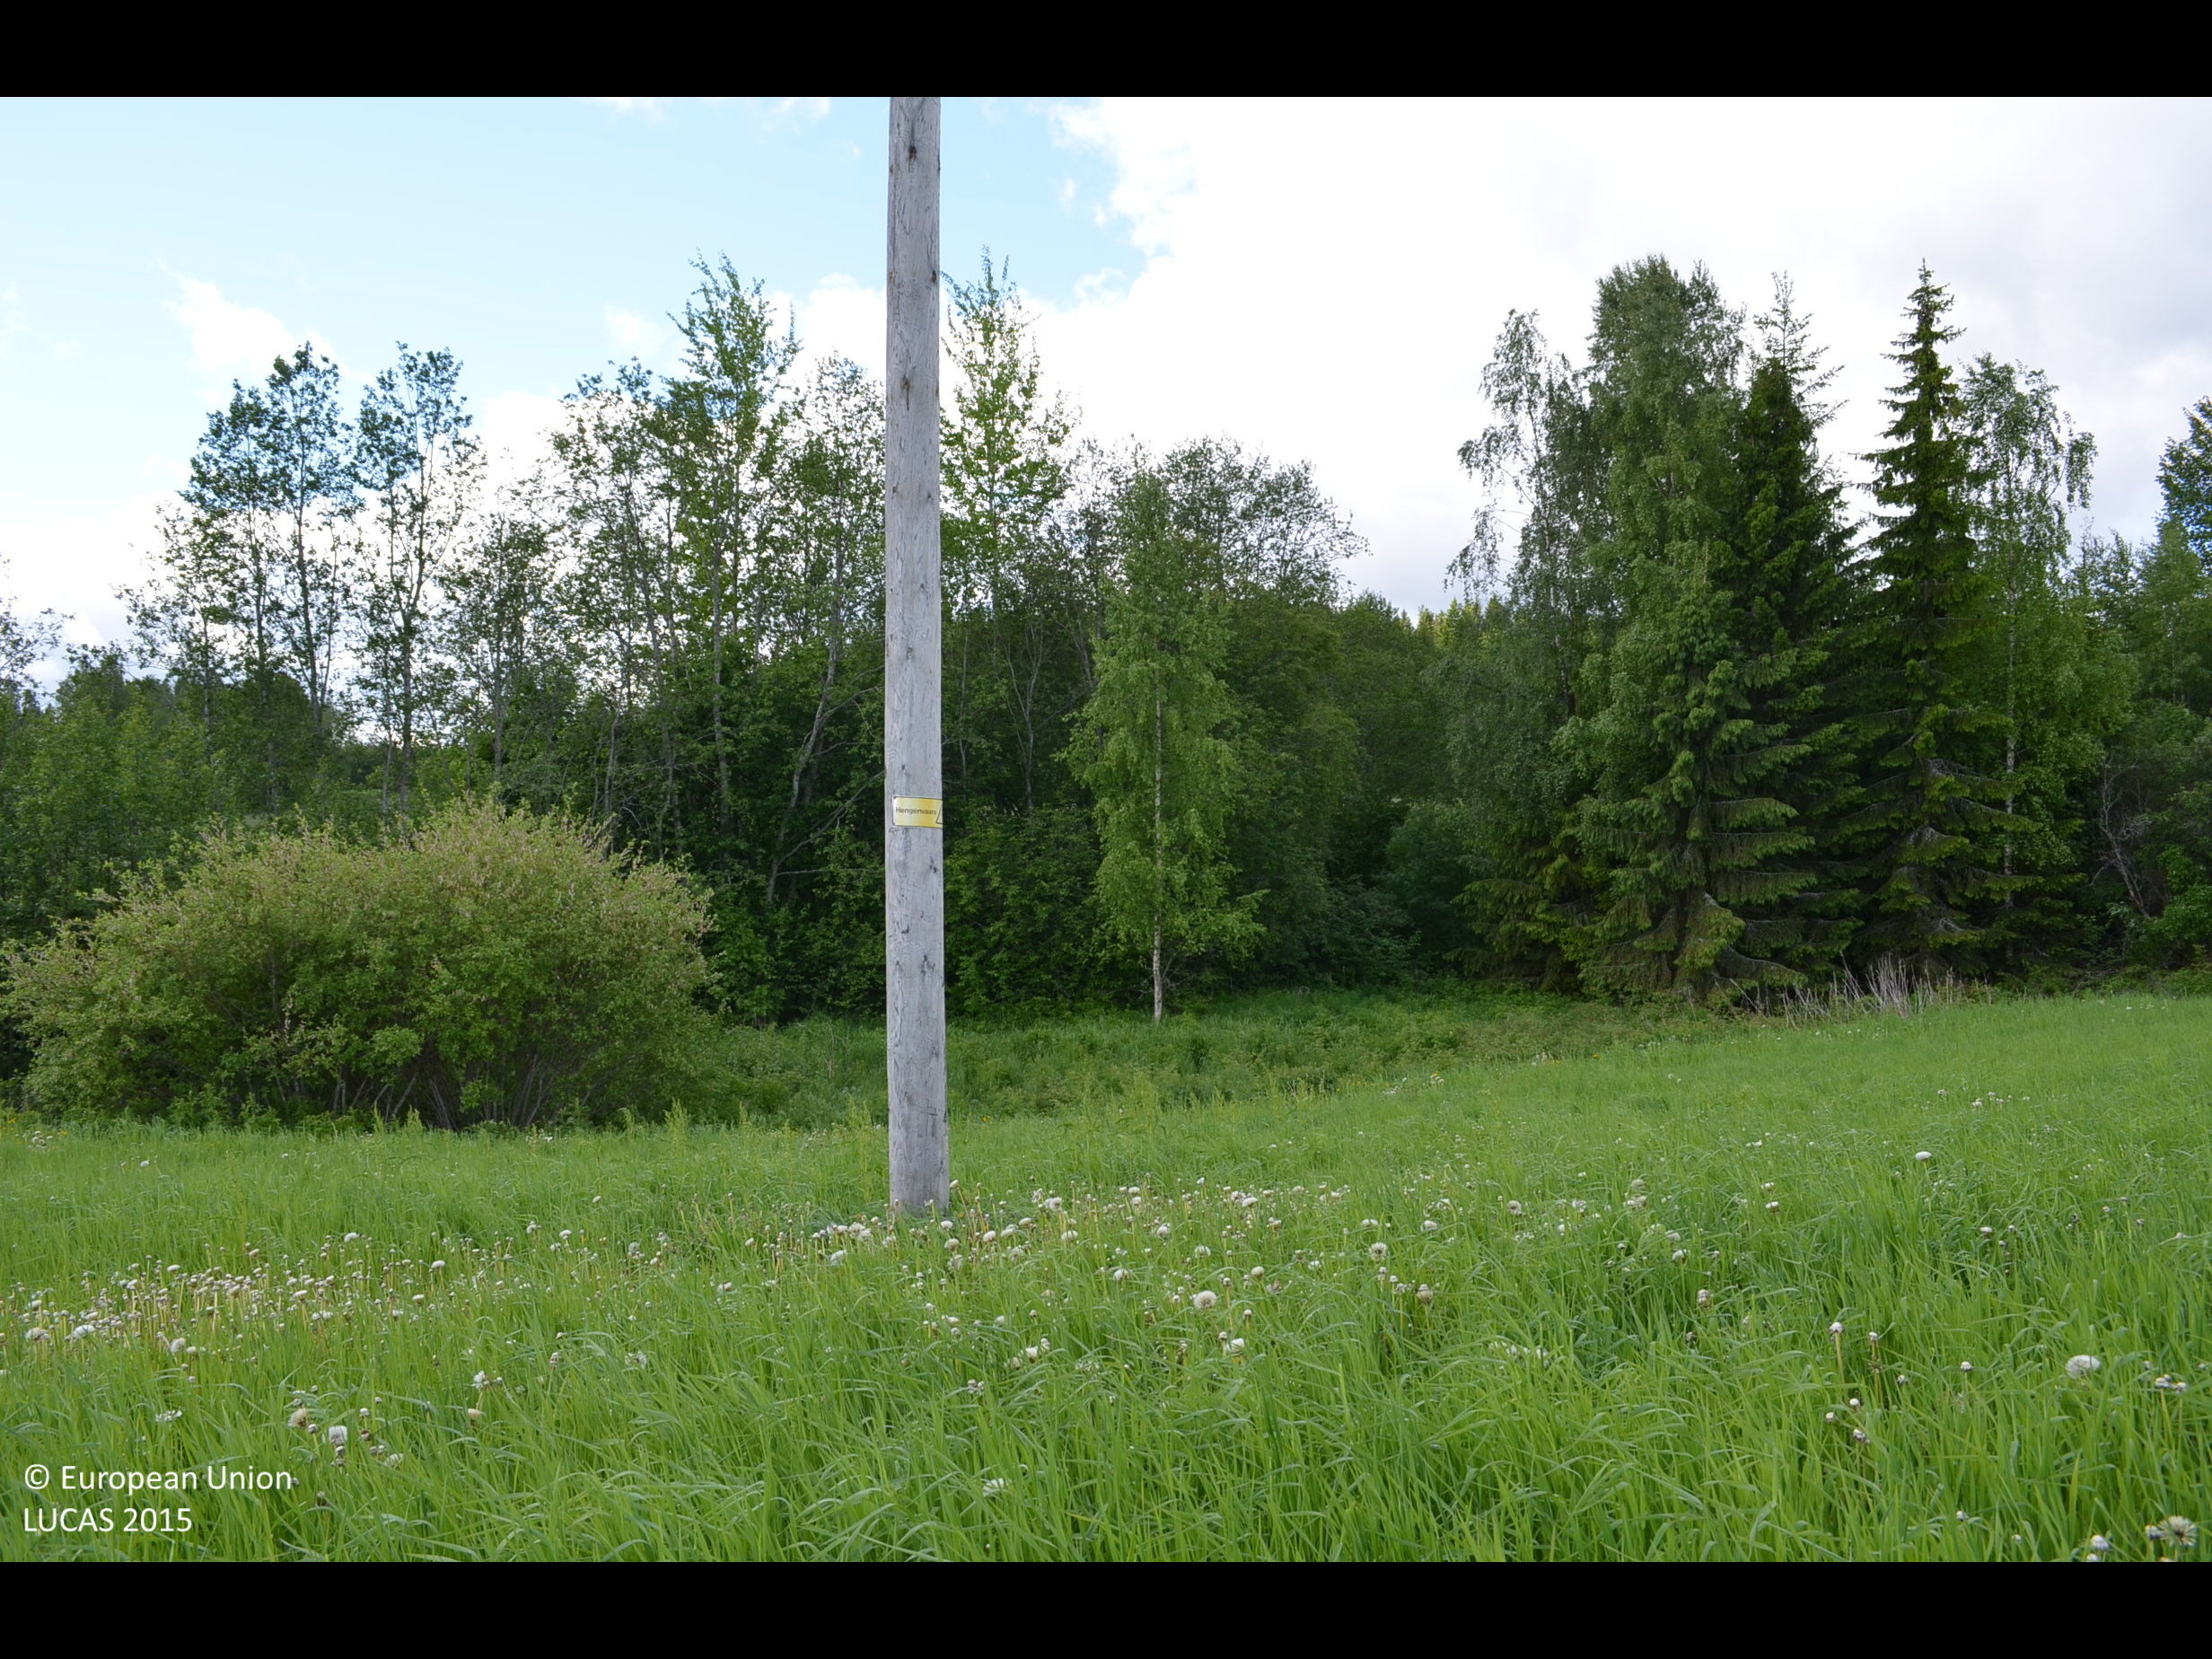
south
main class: Cropland
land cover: Temporary grasslands
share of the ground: > 75 %
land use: Agriculture (excluding fallow land and kitchen gardens)
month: June
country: FI
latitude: 61.8747
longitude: 22.8636
